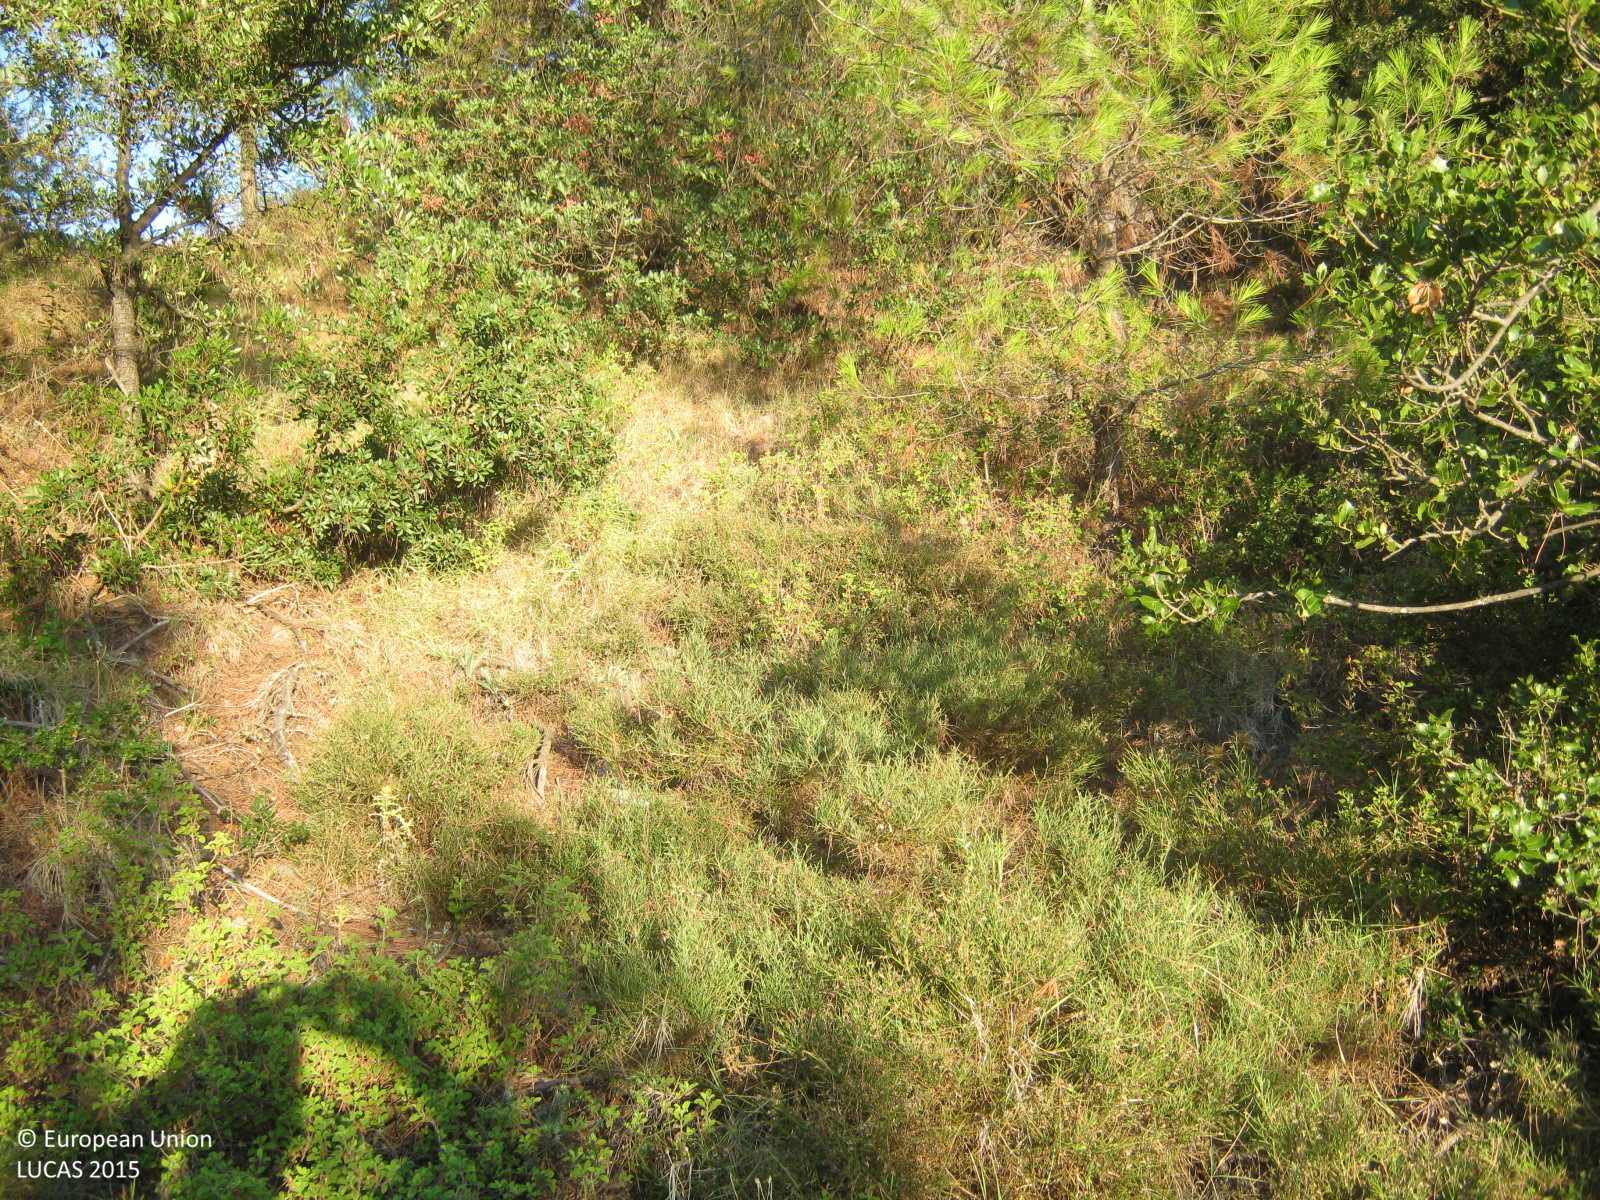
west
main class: Woodland
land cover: Pine dominated mixed woodland
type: coniferous forest of the mediterranean region
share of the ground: > 75 %
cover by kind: coniferous forest trees 65 %, broadleaved forest trees 25 %, shrubs 10 %
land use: Forestry
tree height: > 5 m
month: August
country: GR
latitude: 38.6402
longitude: 23.5795
